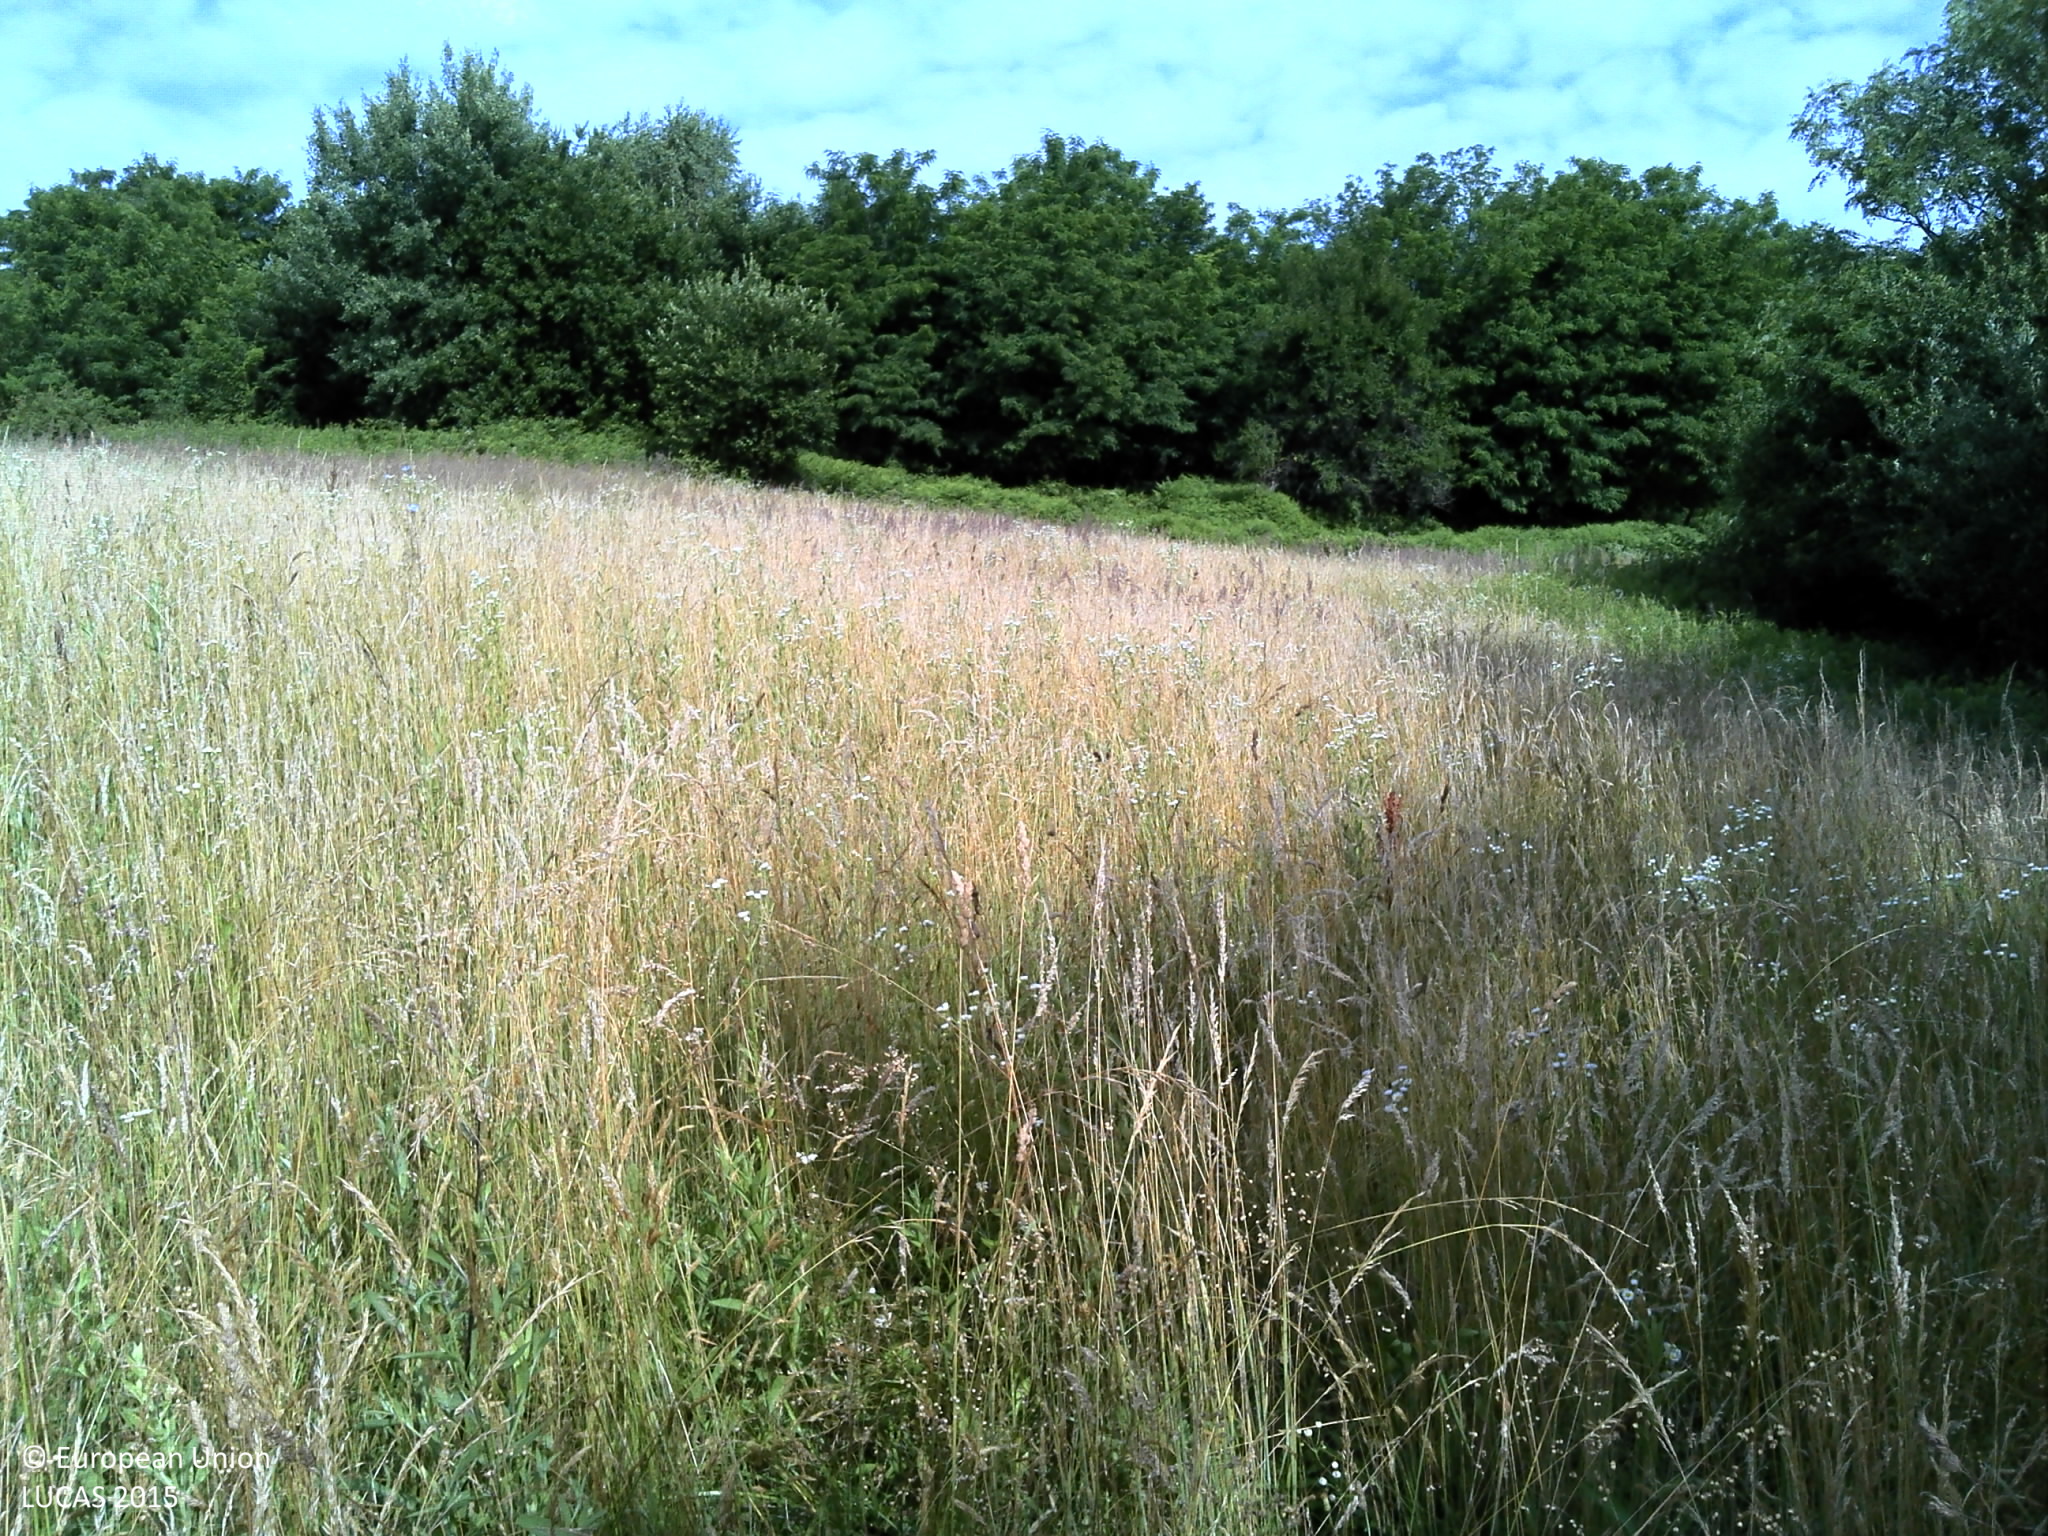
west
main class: Grassland
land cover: Spontaneously vegetated surfaces
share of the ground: > 75 %
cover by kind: herbaceous plants 100 %
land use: Semi-natural and natural areas not in use
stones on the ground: < 10 %
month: June
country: HR
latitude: 45.7425
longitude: 17.5214
